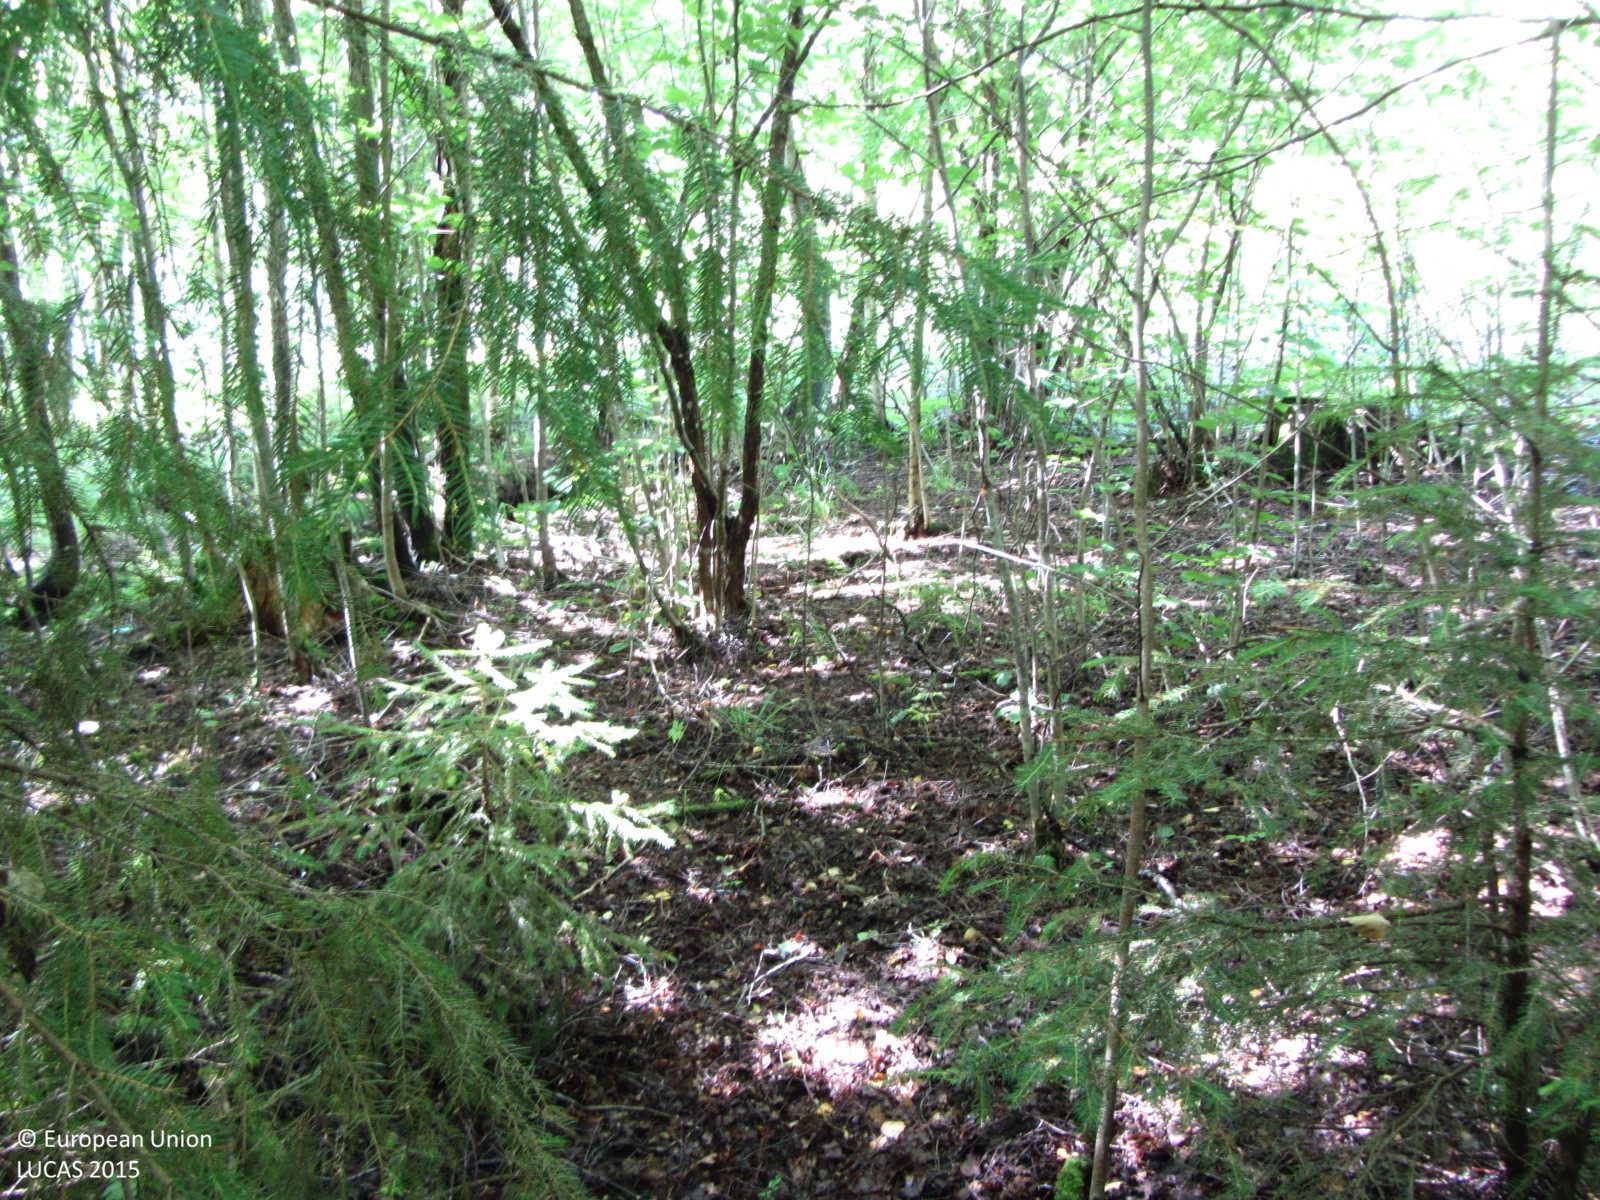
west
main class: Woodland
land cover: Spruce dominated mixed woodland
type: hemiboreal forest and nemoral coniferous forest and mixed broadleaved-coniferous forest
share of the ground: > 75 %
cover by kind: broadleaved forest trees 55 %, coniferous forest trees 35 %, herbaceous plants 10 %
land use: Forestry
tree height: > 5 m
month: July
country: FI
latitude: 60.1841
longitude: 24.4415
